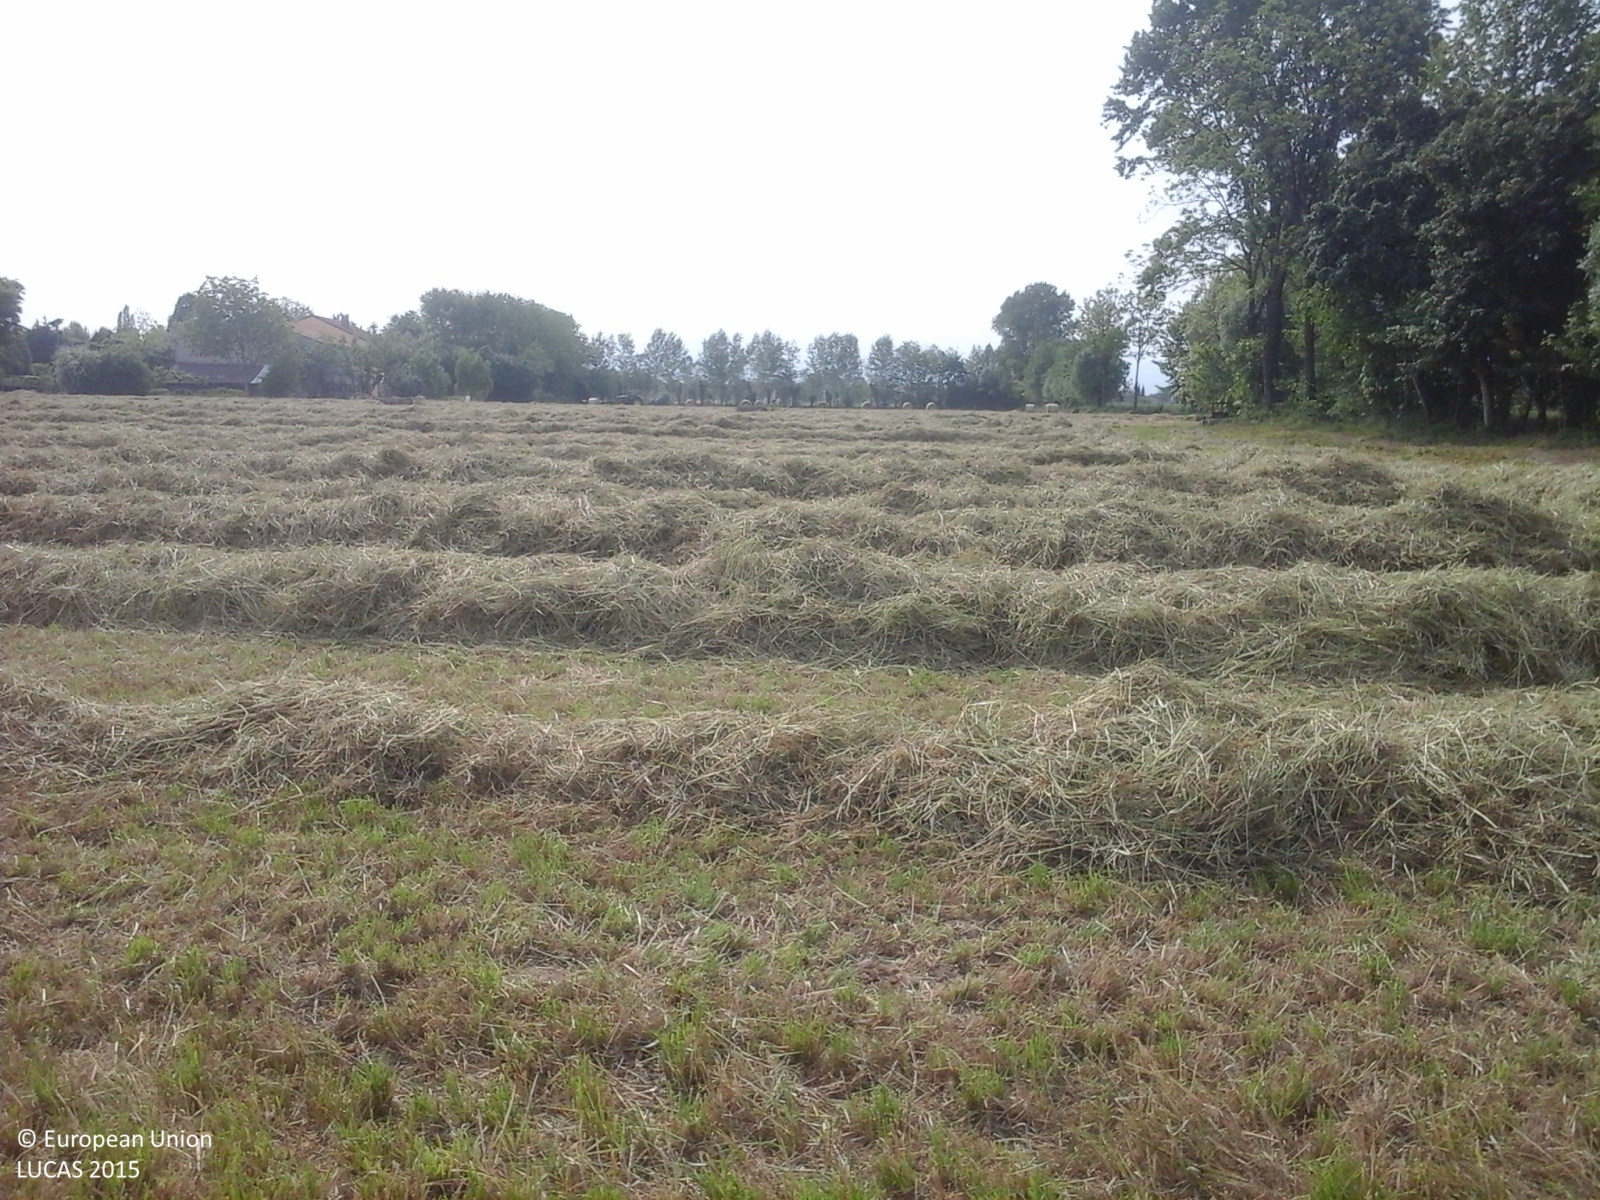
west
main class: Cropland
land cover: Temporary grasslands
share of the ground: > 75 %
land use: Agriculture (excluding fallow land and kitchen gardens)
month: May
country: IT
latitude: 45.6537
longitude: 11.6528
